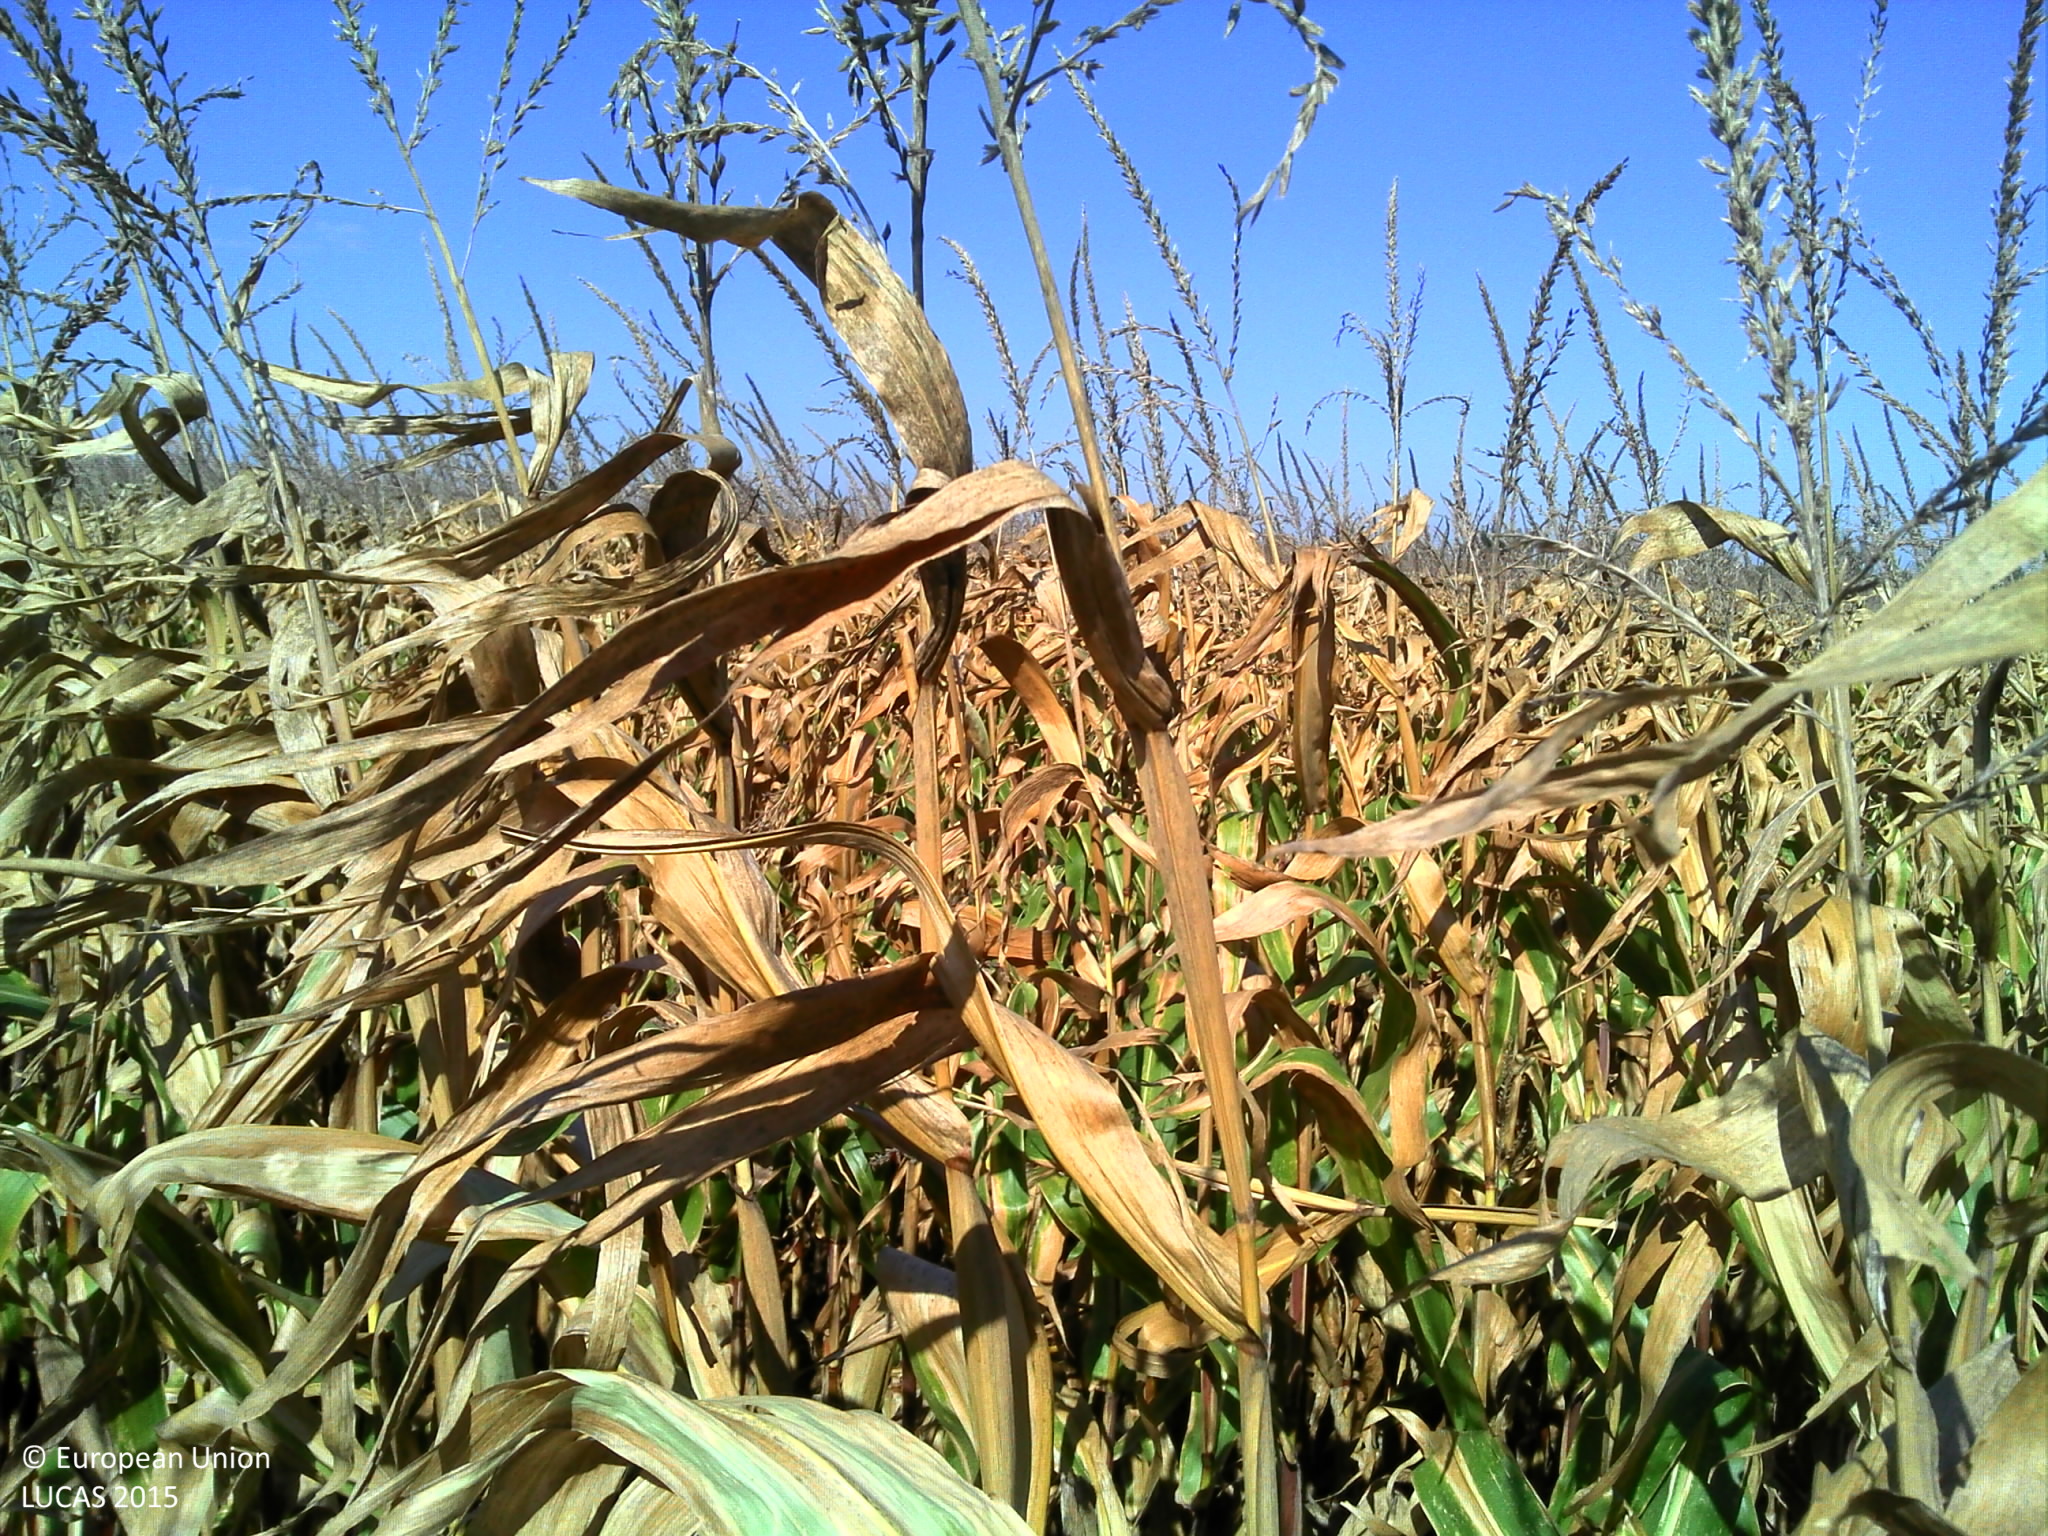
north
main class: Cropland
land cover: Maize
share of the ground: > 75 %
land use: Agriculture (excluding fallow land and kitchen gardens)
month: September
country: FR
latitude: 46.4963
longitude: -1.1212
